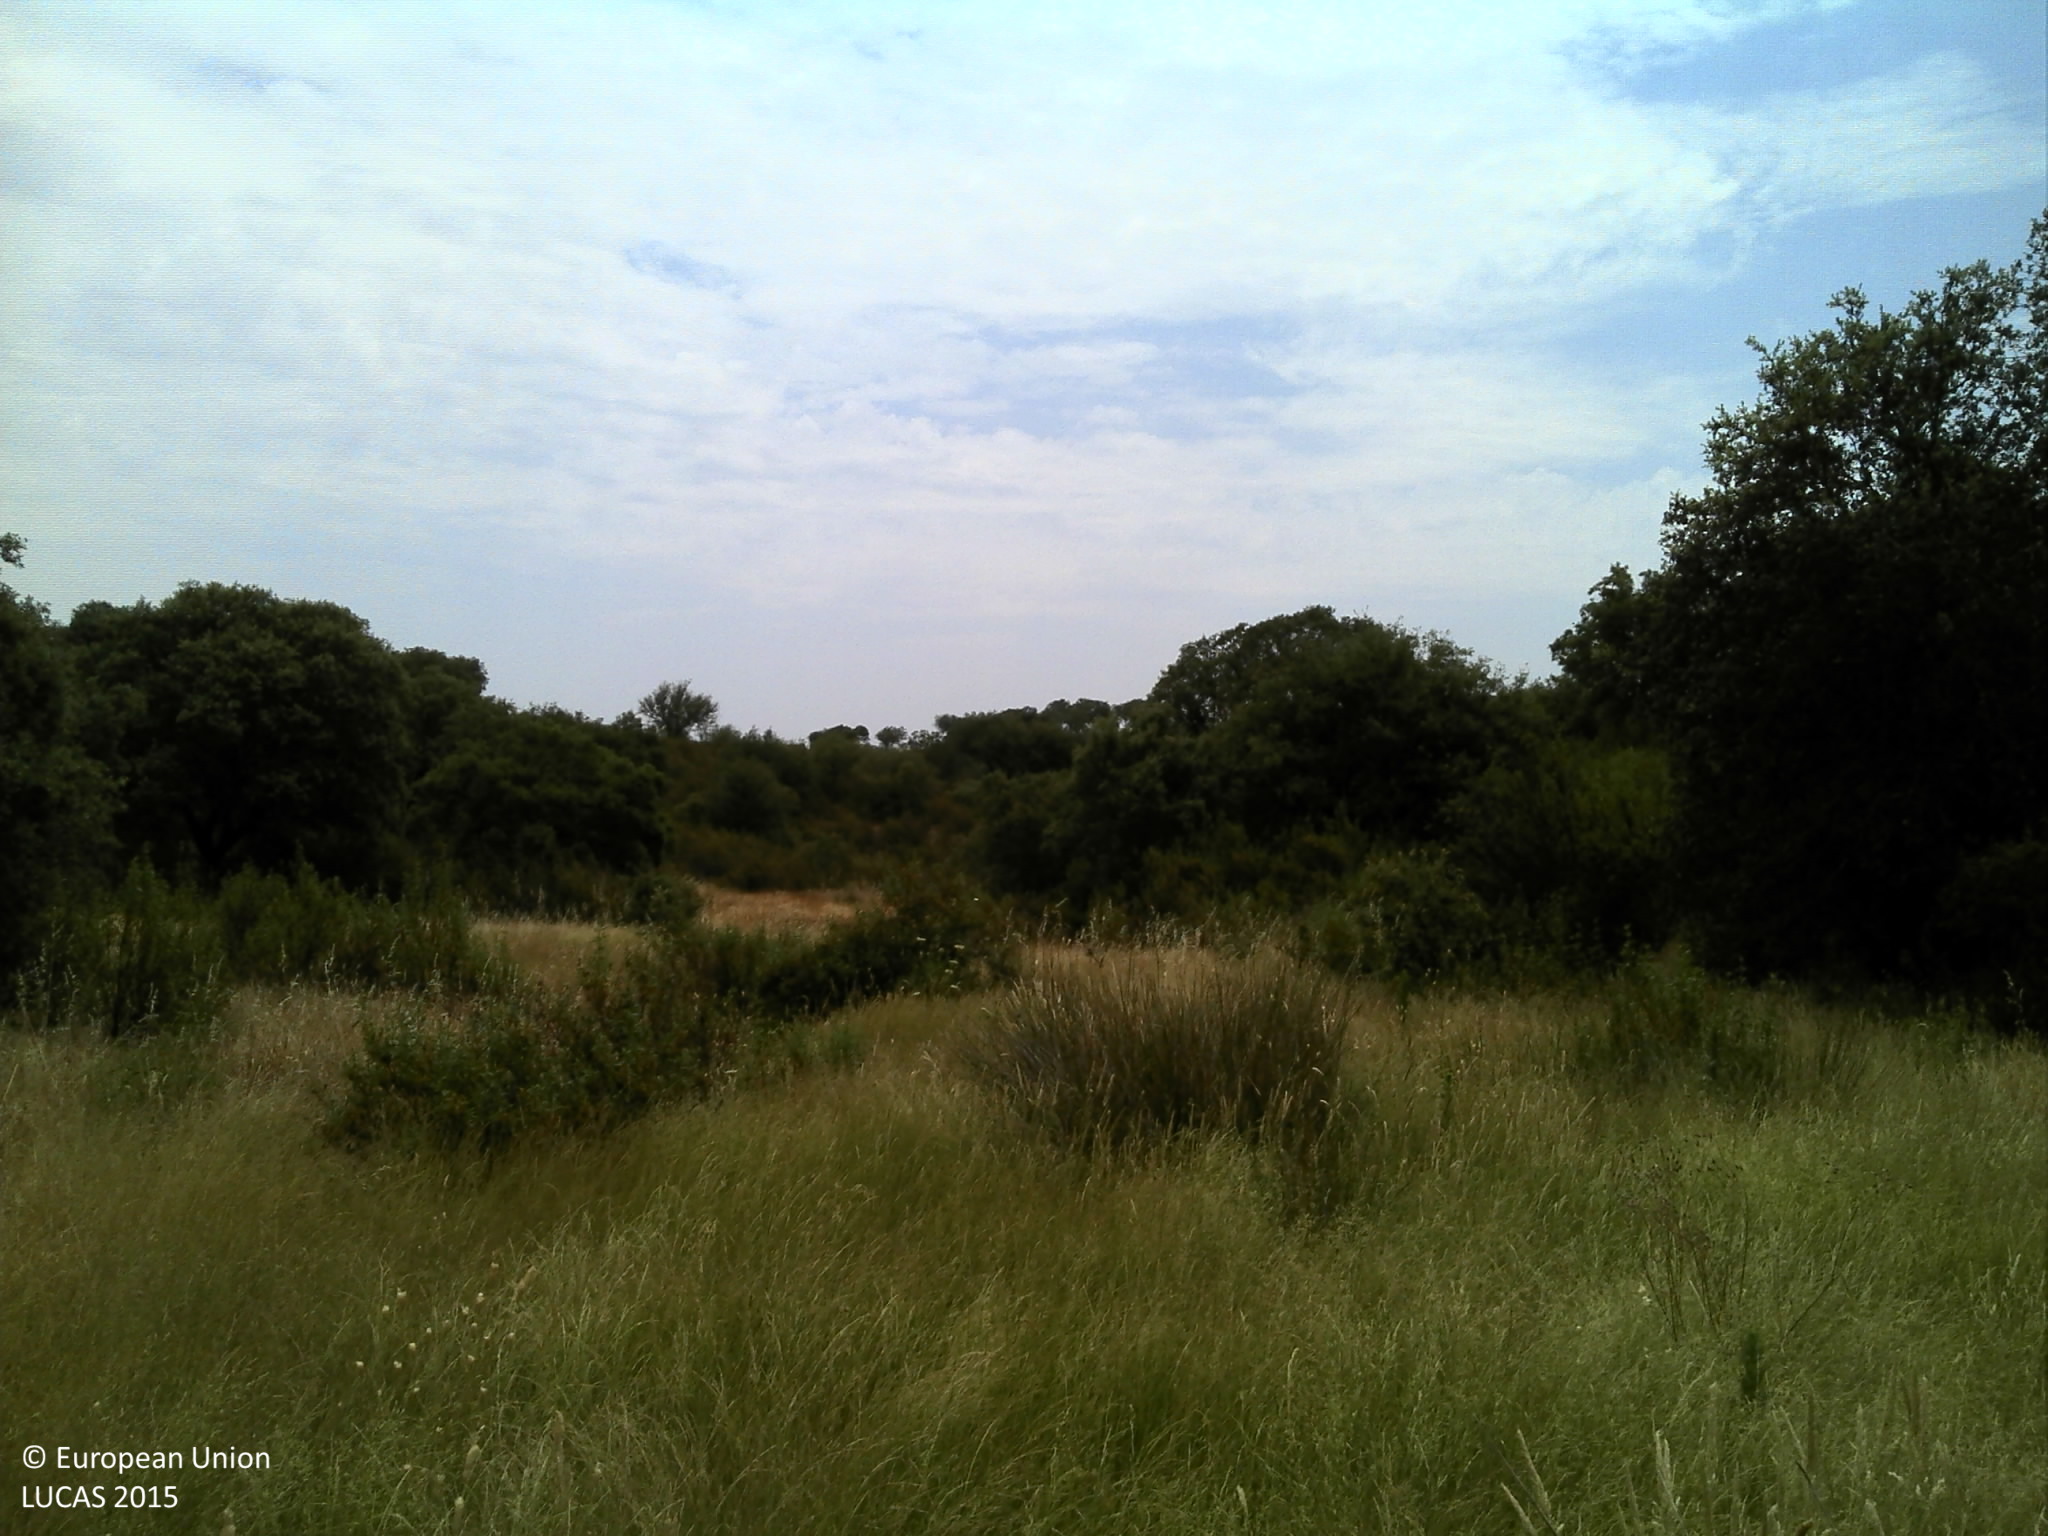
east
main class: Woodland
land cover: Broadleaved woodland
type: broadleaved evergreen forest
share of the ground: 10 - 25 %
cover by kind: shrubs 30 %, herbaceous plants 30 %, broadleaved forest trees 20 %, unconsolidated bare surface 20 %
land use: Forestry
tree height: > 5 m
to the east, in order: Broadleaved woodland; Shrubland with sparse tree cover; Broadleaved woodland; Shrubland with sparse tree cover; Broadleaved woodland; Shrubland with sparse tree cover
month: June
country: PT
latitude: 38.5665
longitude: -7.8150
